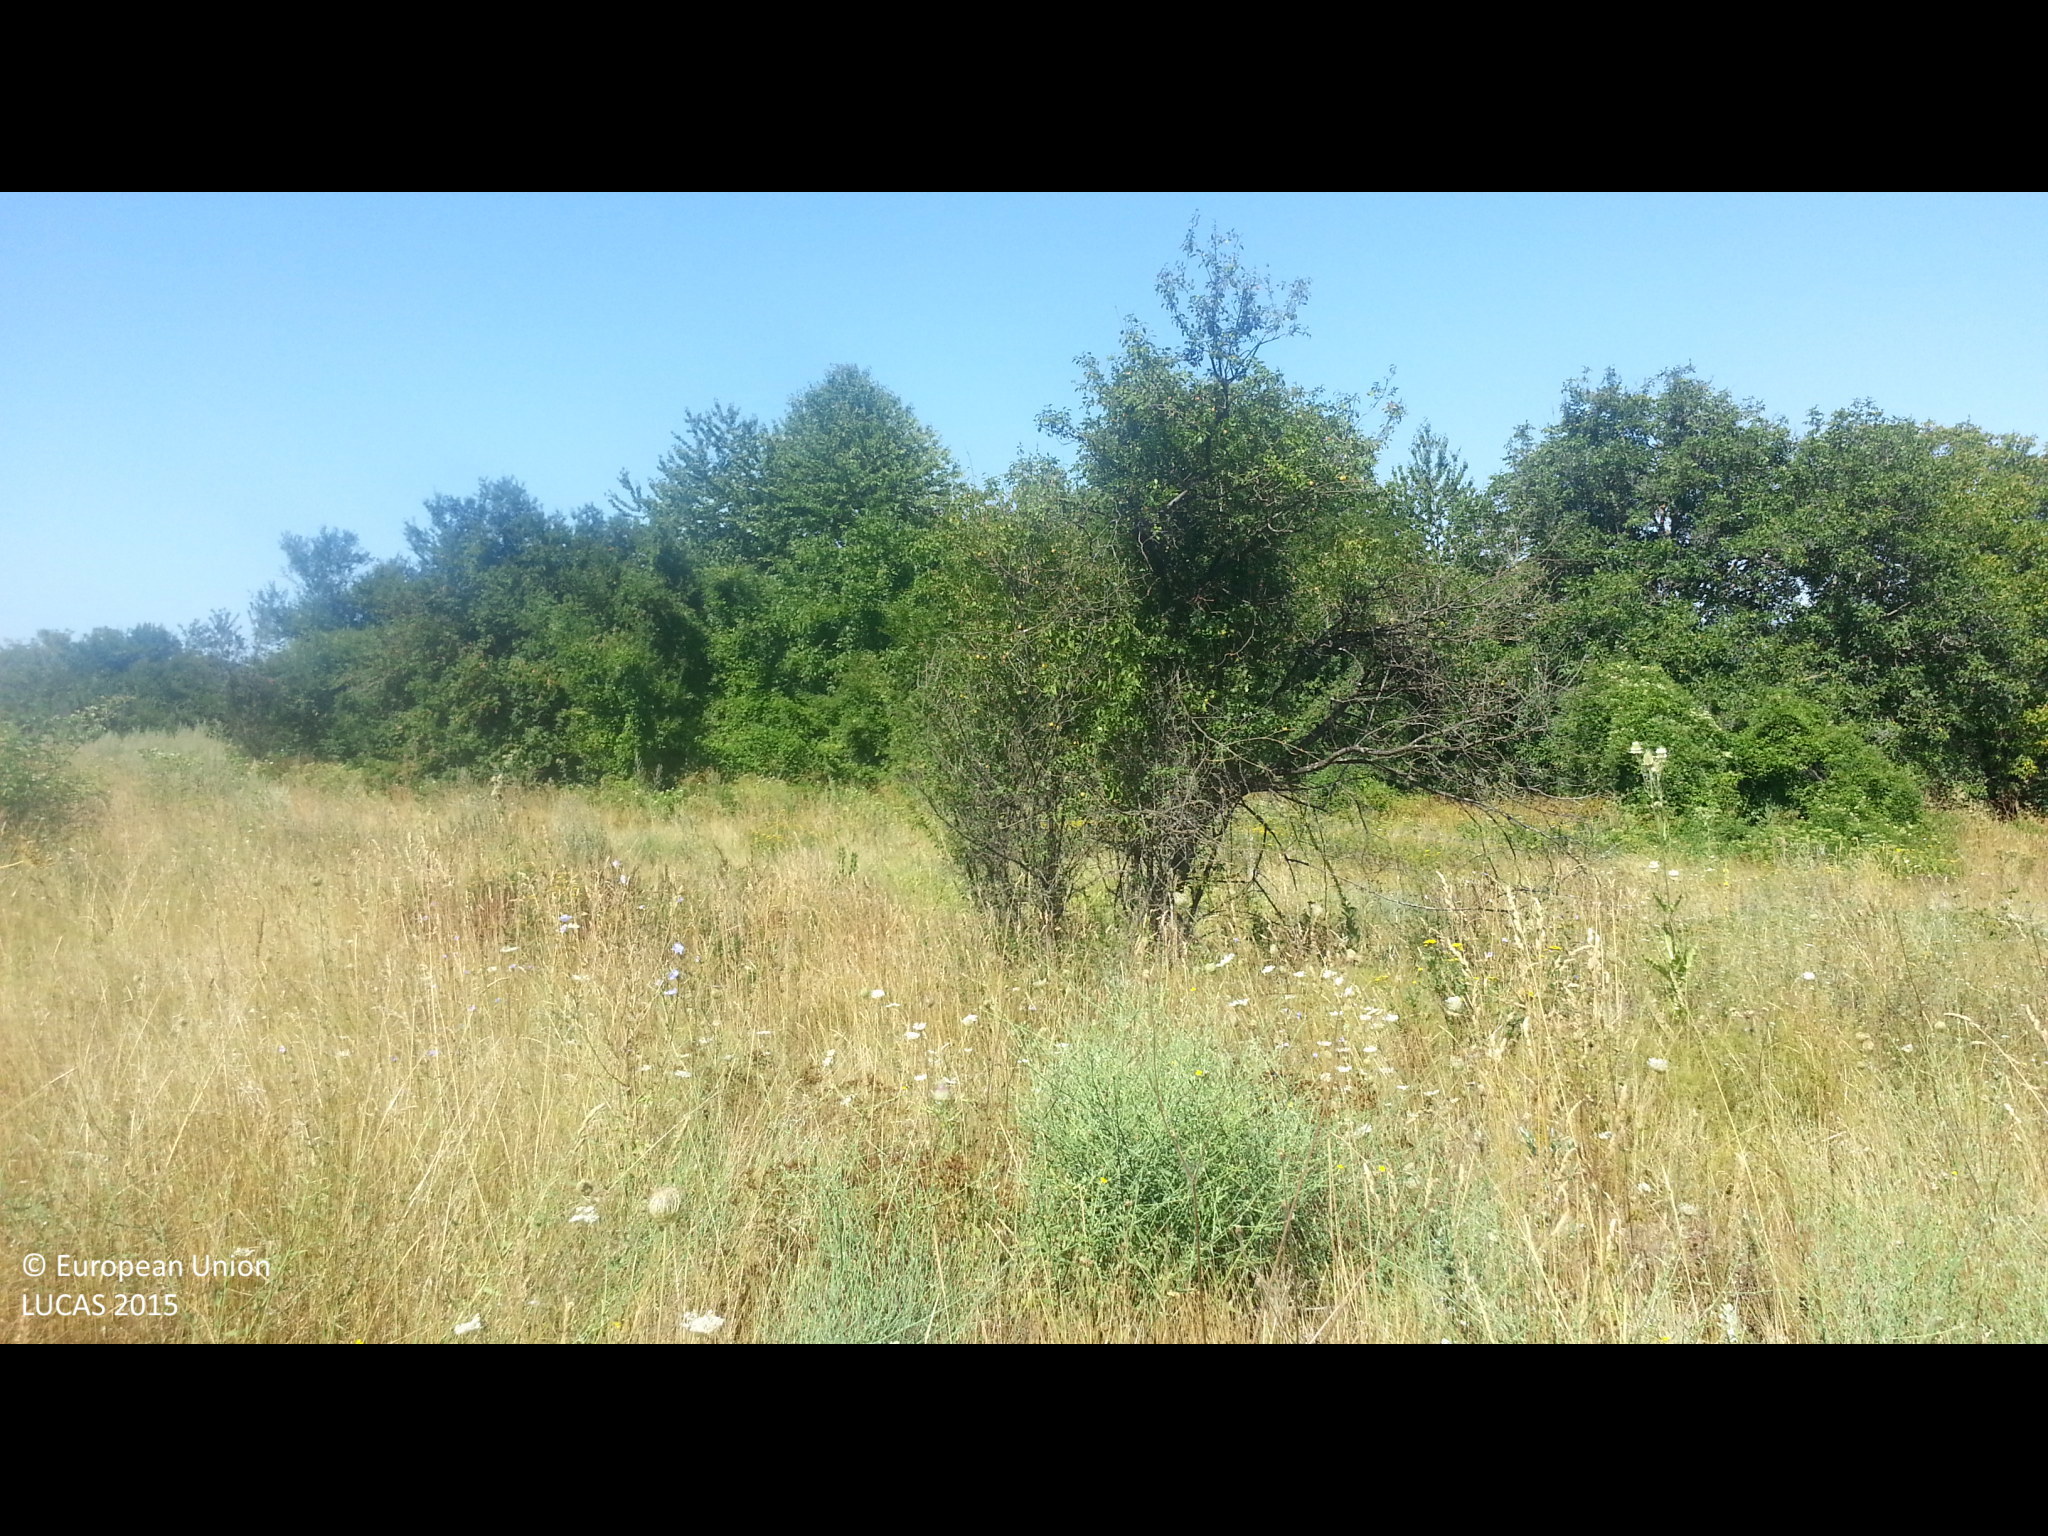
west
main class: Grassland
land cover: Grassland without tree/shrub cover
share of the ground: > 75 %
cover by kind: herbaceous plants 100 %
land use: Semi-natural and natural areas not in use
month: August
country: BG
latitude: 42.2398
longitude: 22.5132
